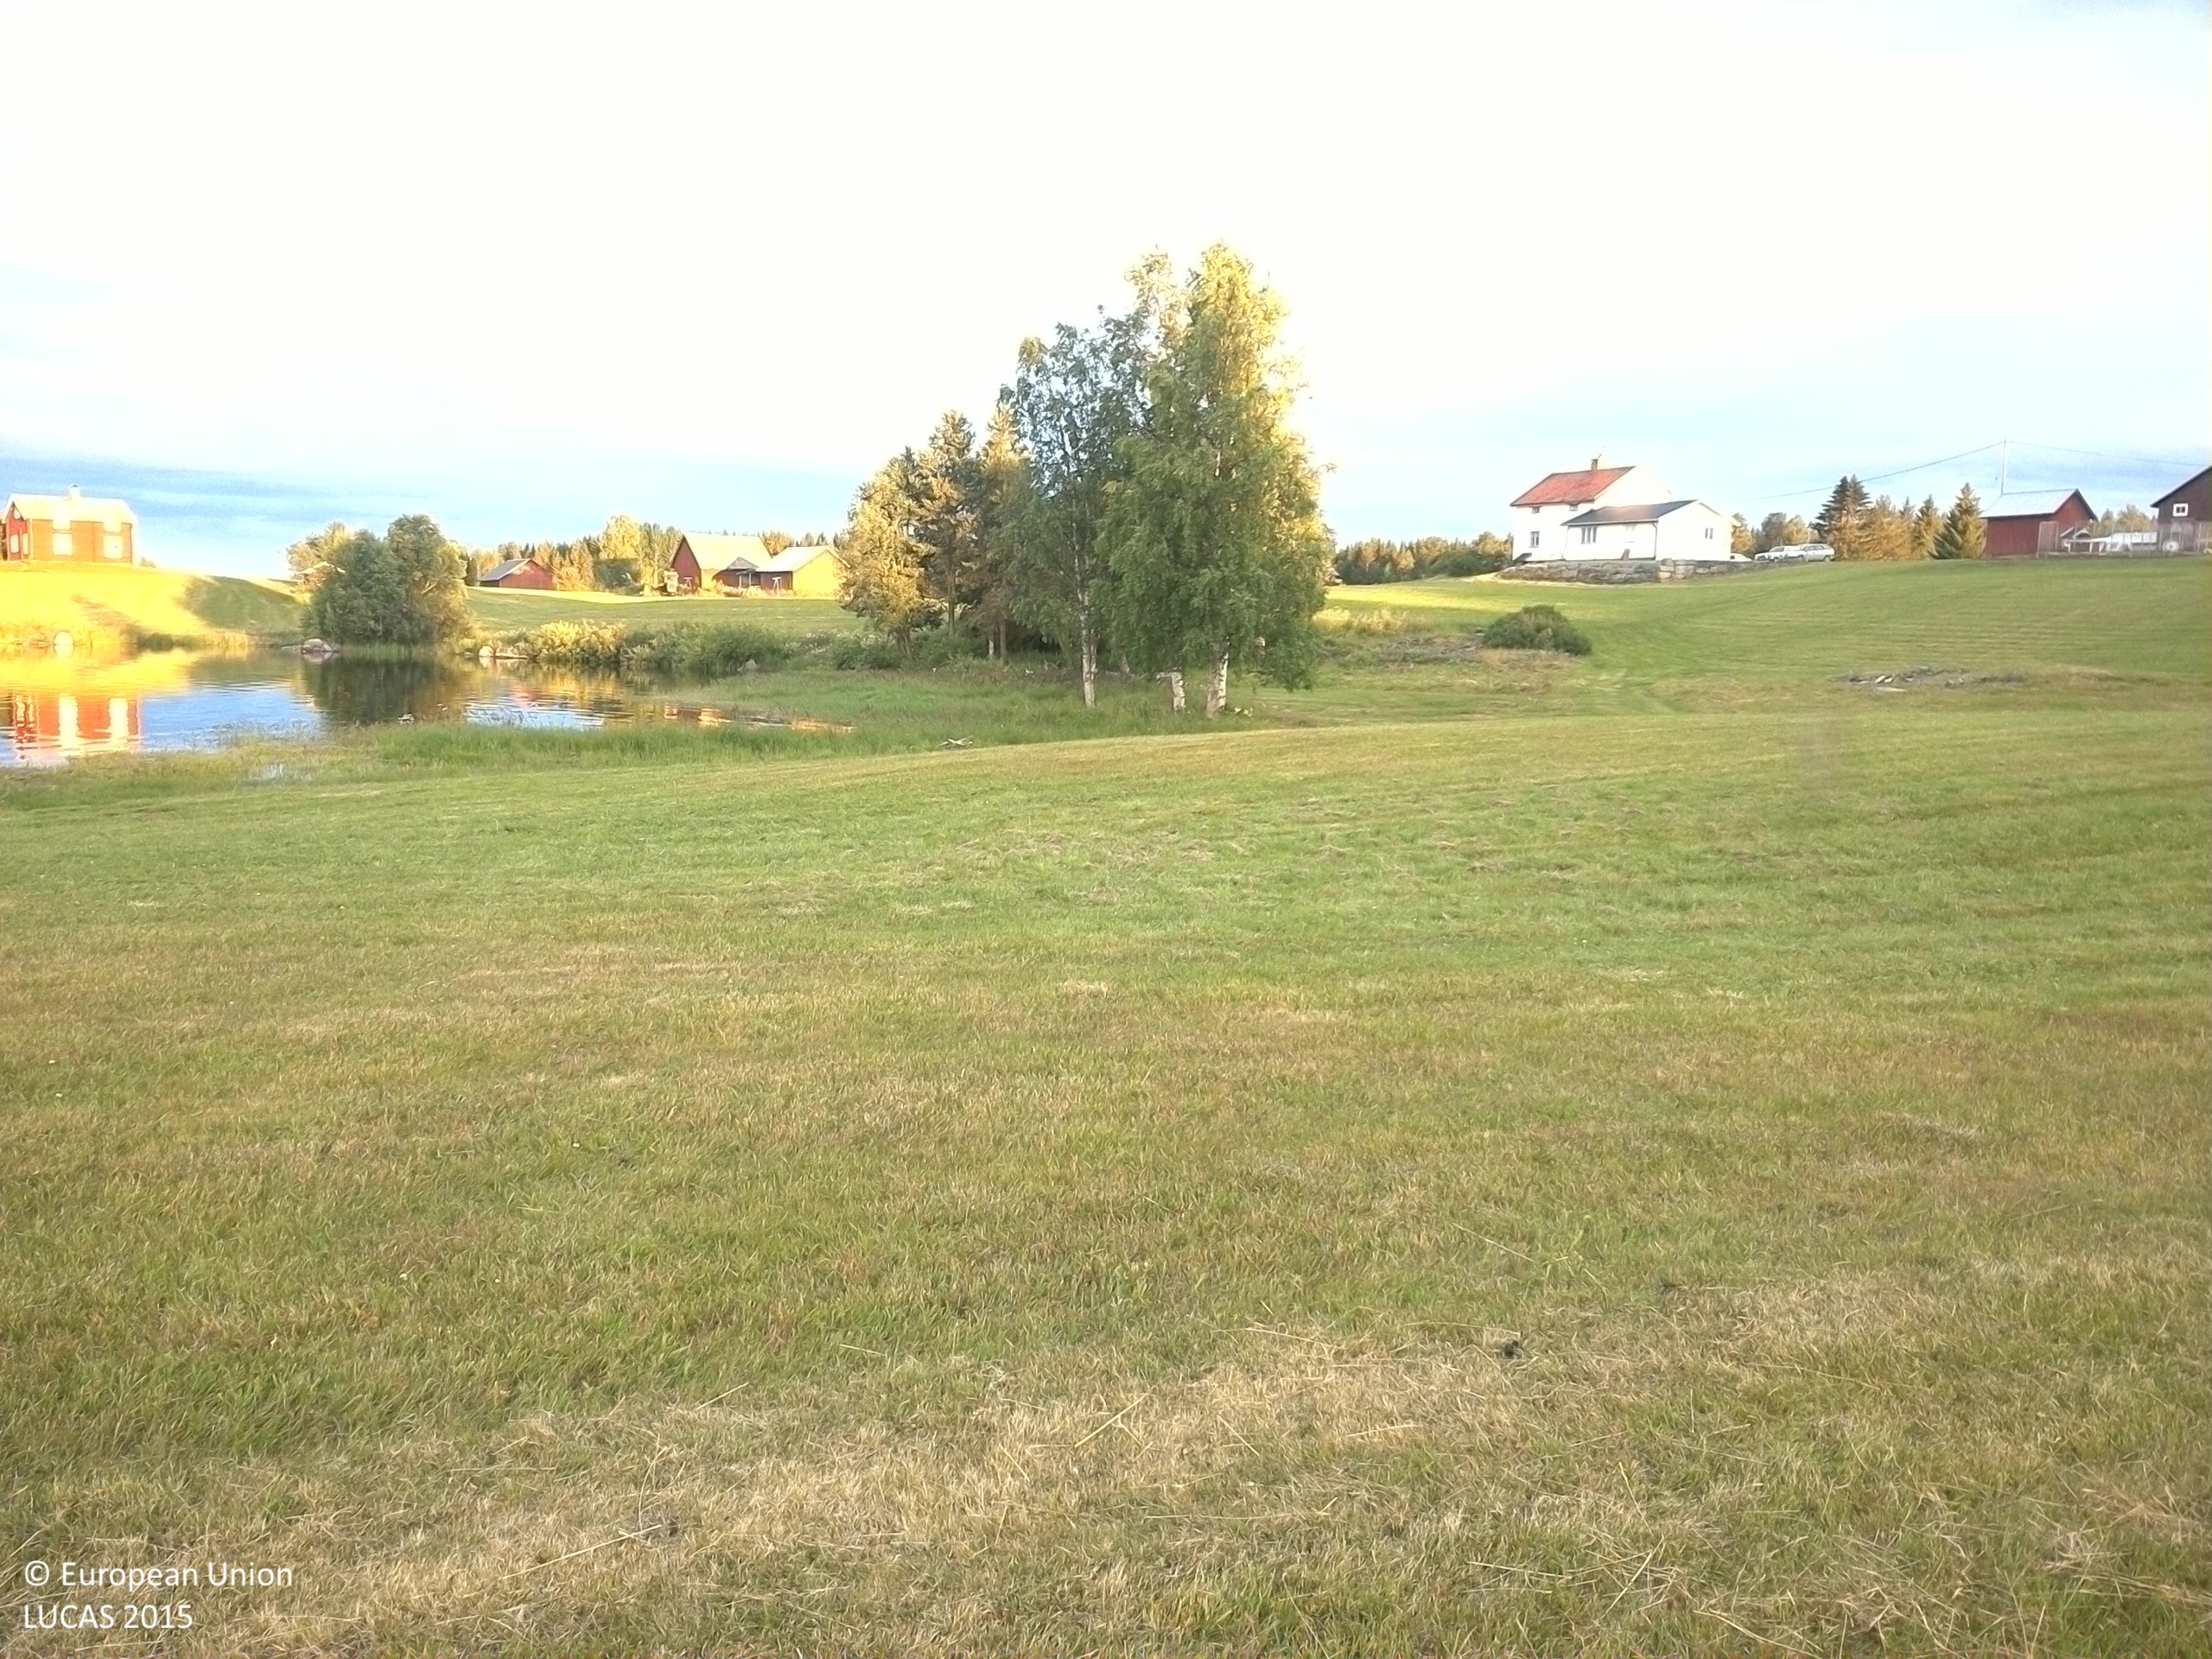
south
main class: Grassland
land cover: Grassland without tree/shrub cover
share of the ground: > 75 %
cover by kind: herbaceous plants 100 %
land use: Residential
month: July
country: SE
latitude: 64.3932
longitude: 16.0040
